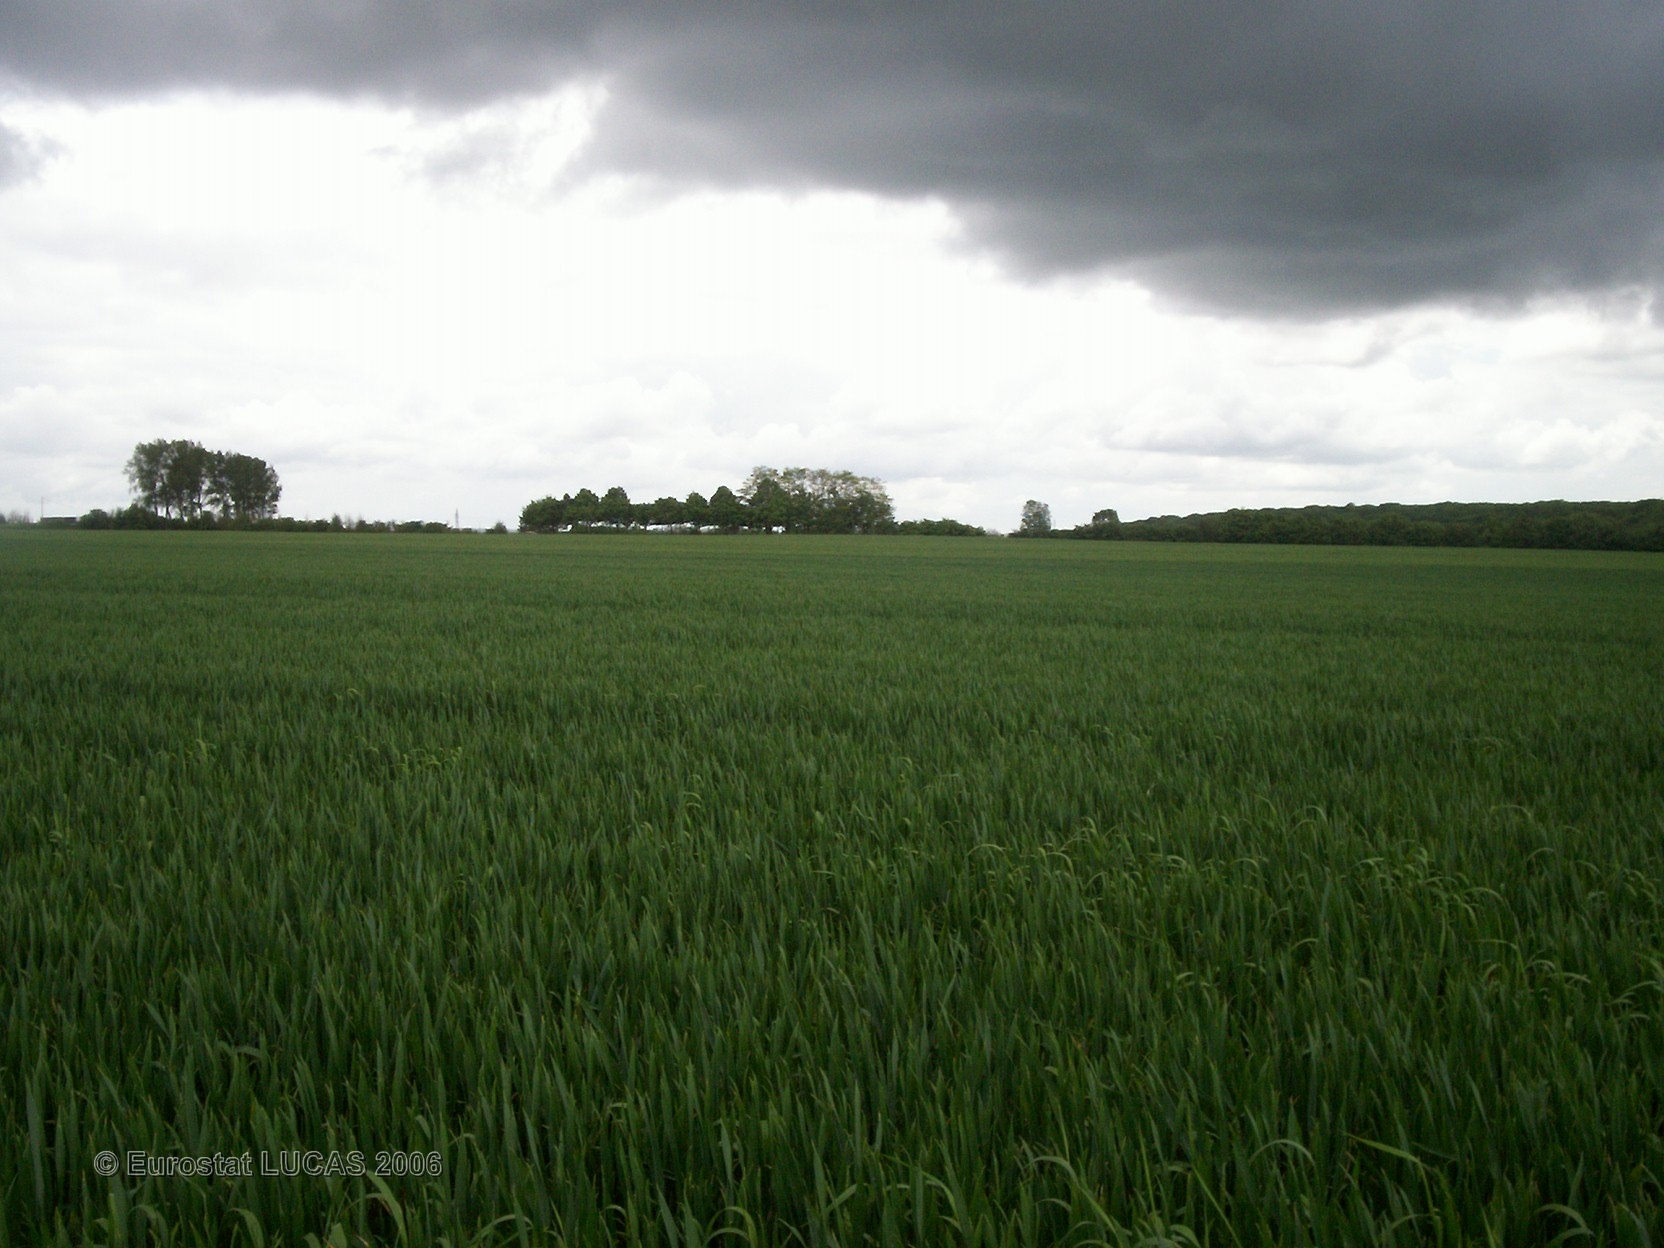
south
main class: Cropland
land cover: Common wheat
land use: Agriculture (excluding fallow land and kitchen gardens)
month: May
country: FR
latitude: 49.8535
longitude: 2.6027
